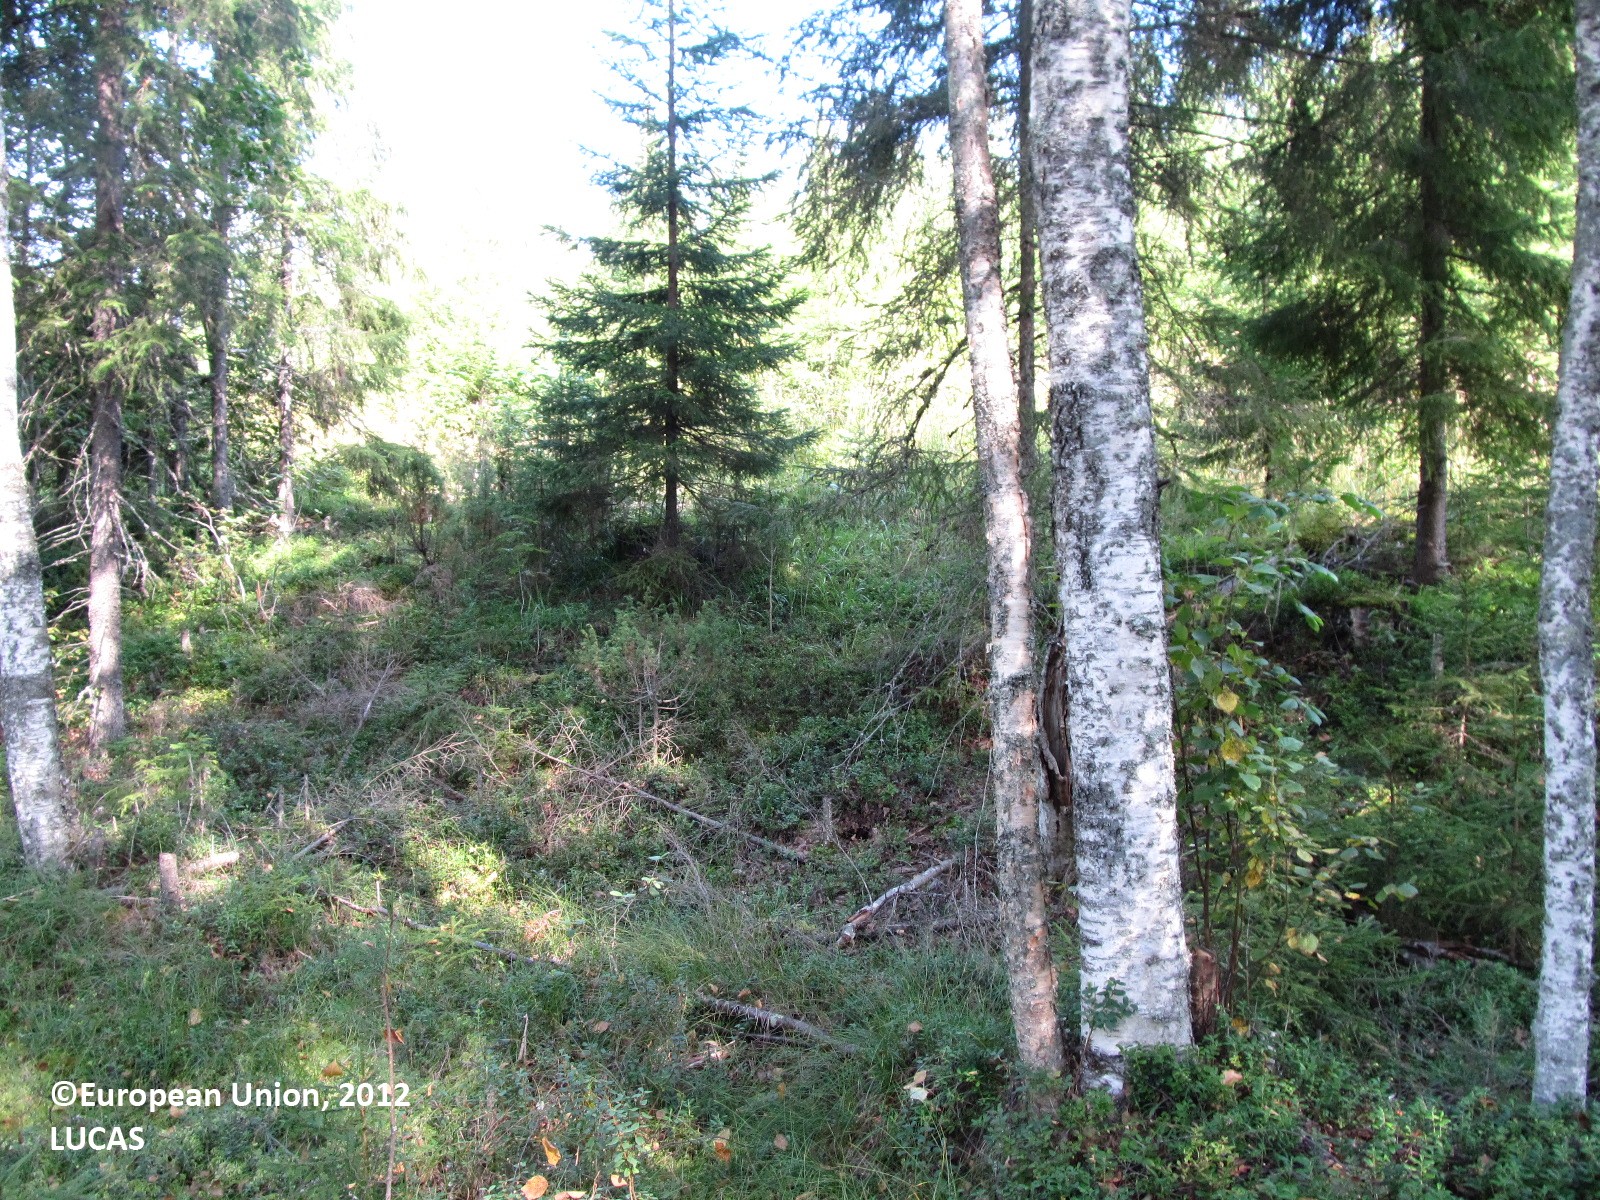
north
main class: Woodland
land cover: Pine dominated mixed woodland
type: boreal forest
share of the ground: > 75 %
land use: Forestry
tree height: > 5 m
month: August
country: FI
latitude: 62.4152
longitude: 27.4531
